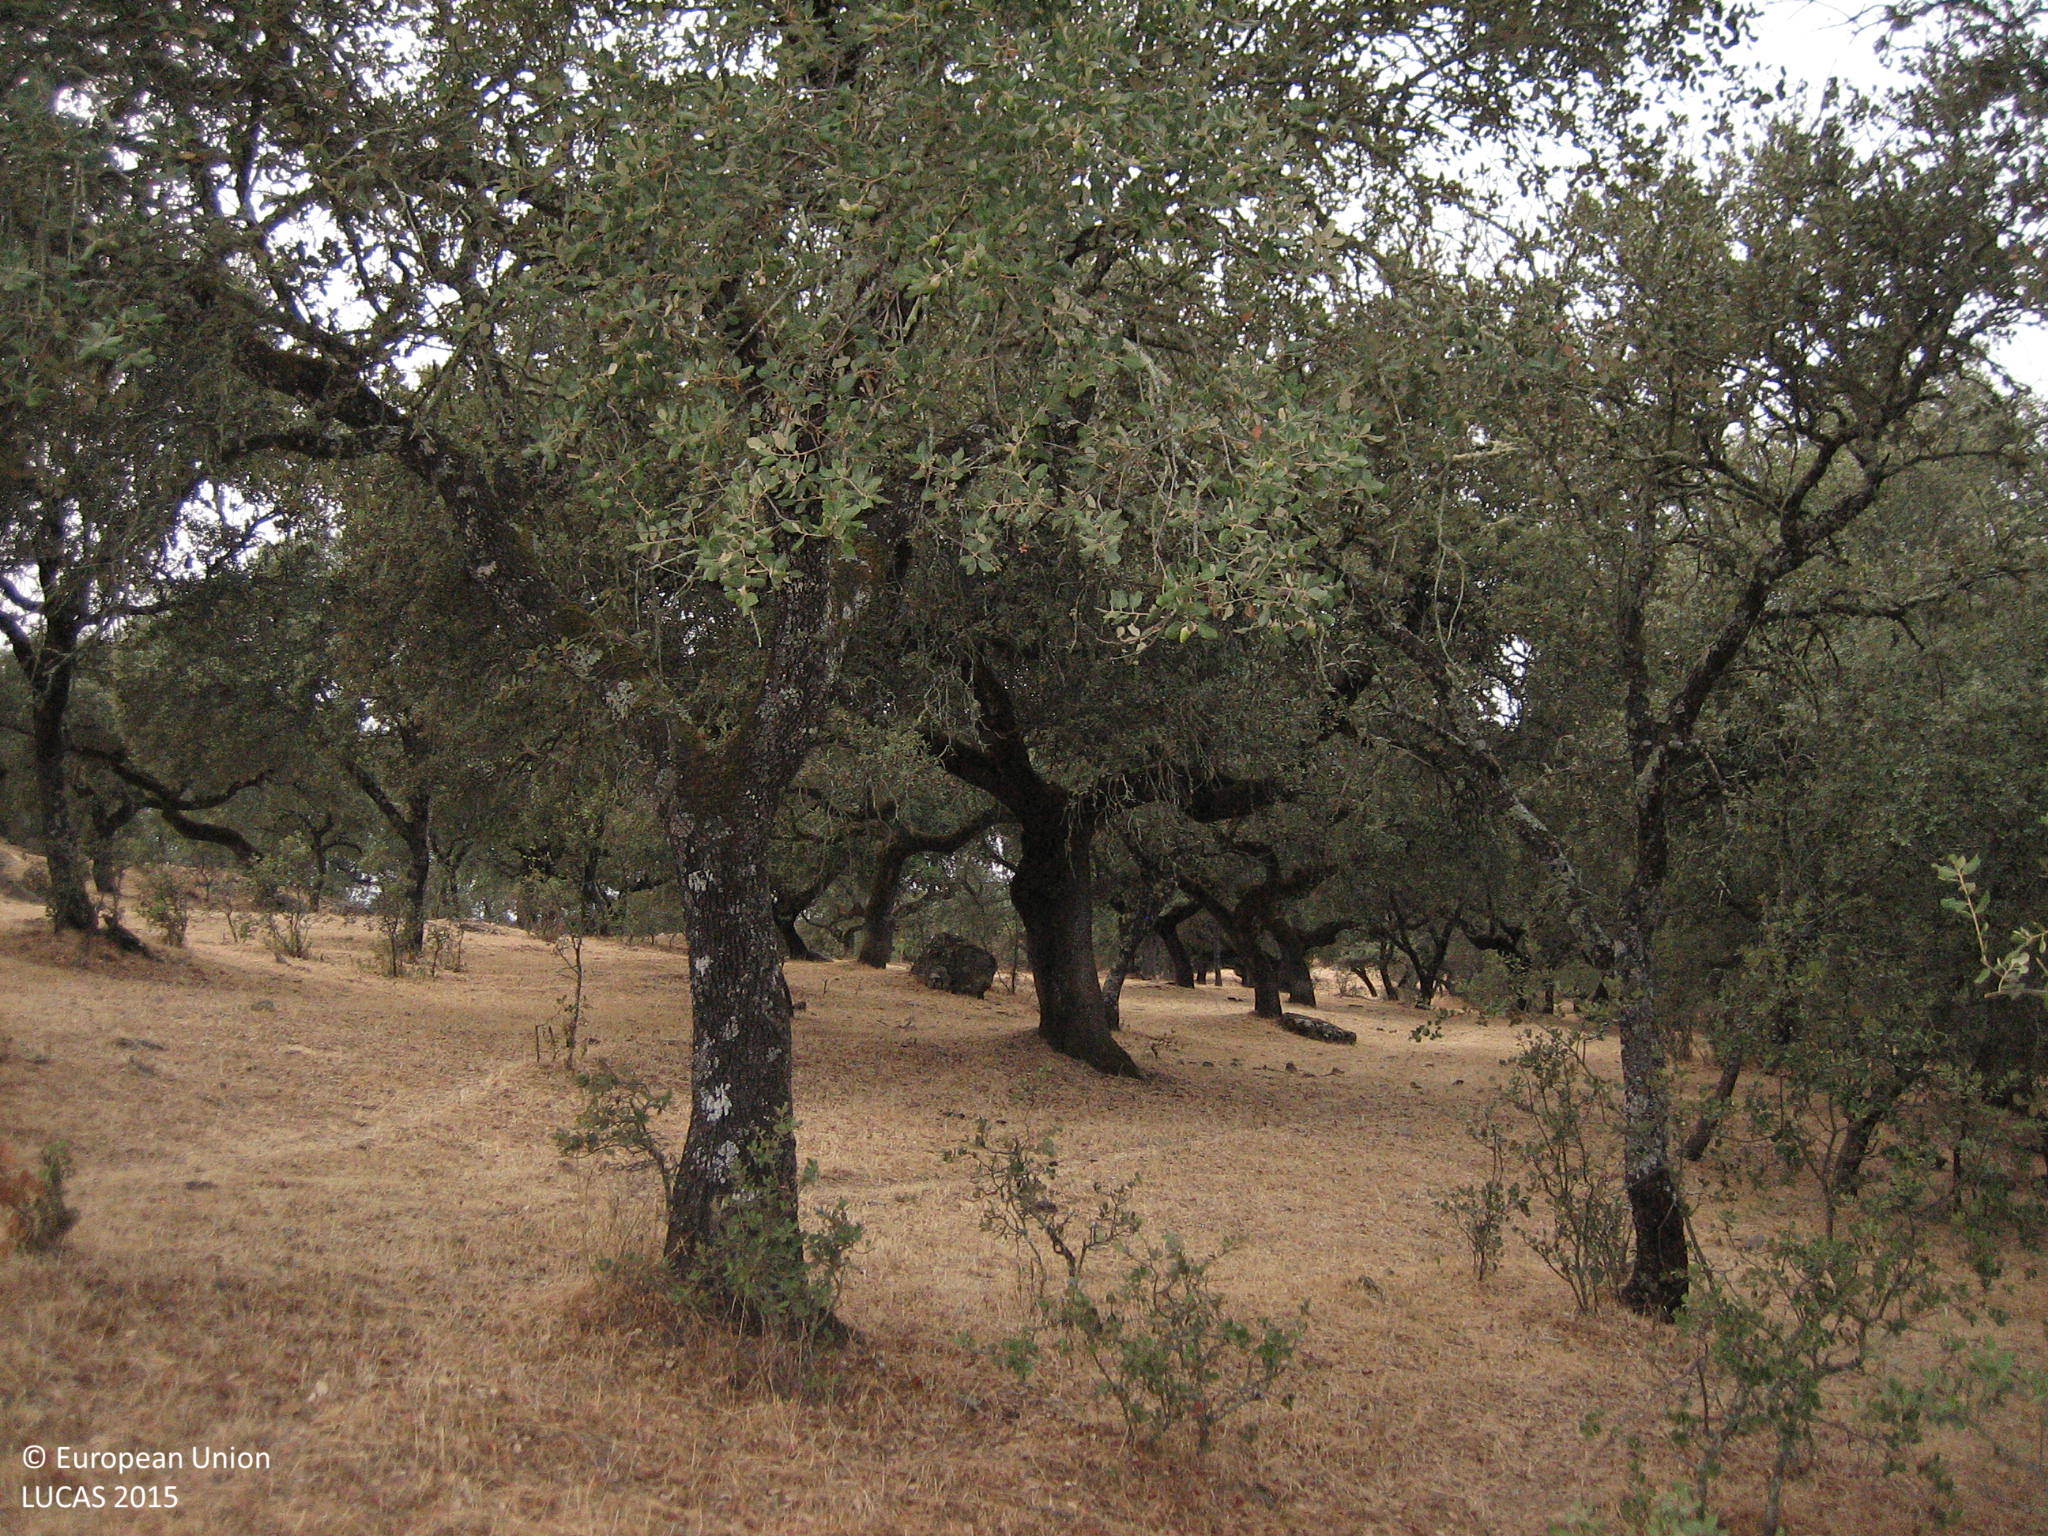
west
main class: Woodland
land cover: Broadleaved woodland
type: broadleaved evergreen forest
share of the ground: 25 - 50 %
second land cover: Grassland without tree/shrub cover
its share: > 75 %
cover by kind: herbaceous plants 55 %, broadleaved forest trees 40 %, shrubs 5 %
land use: Forestry
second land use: Agriculture (excluding fallow land and kitchen gardens)
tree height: > 5 m
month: September
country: ES
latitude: 38.3386
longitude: -6.8409
